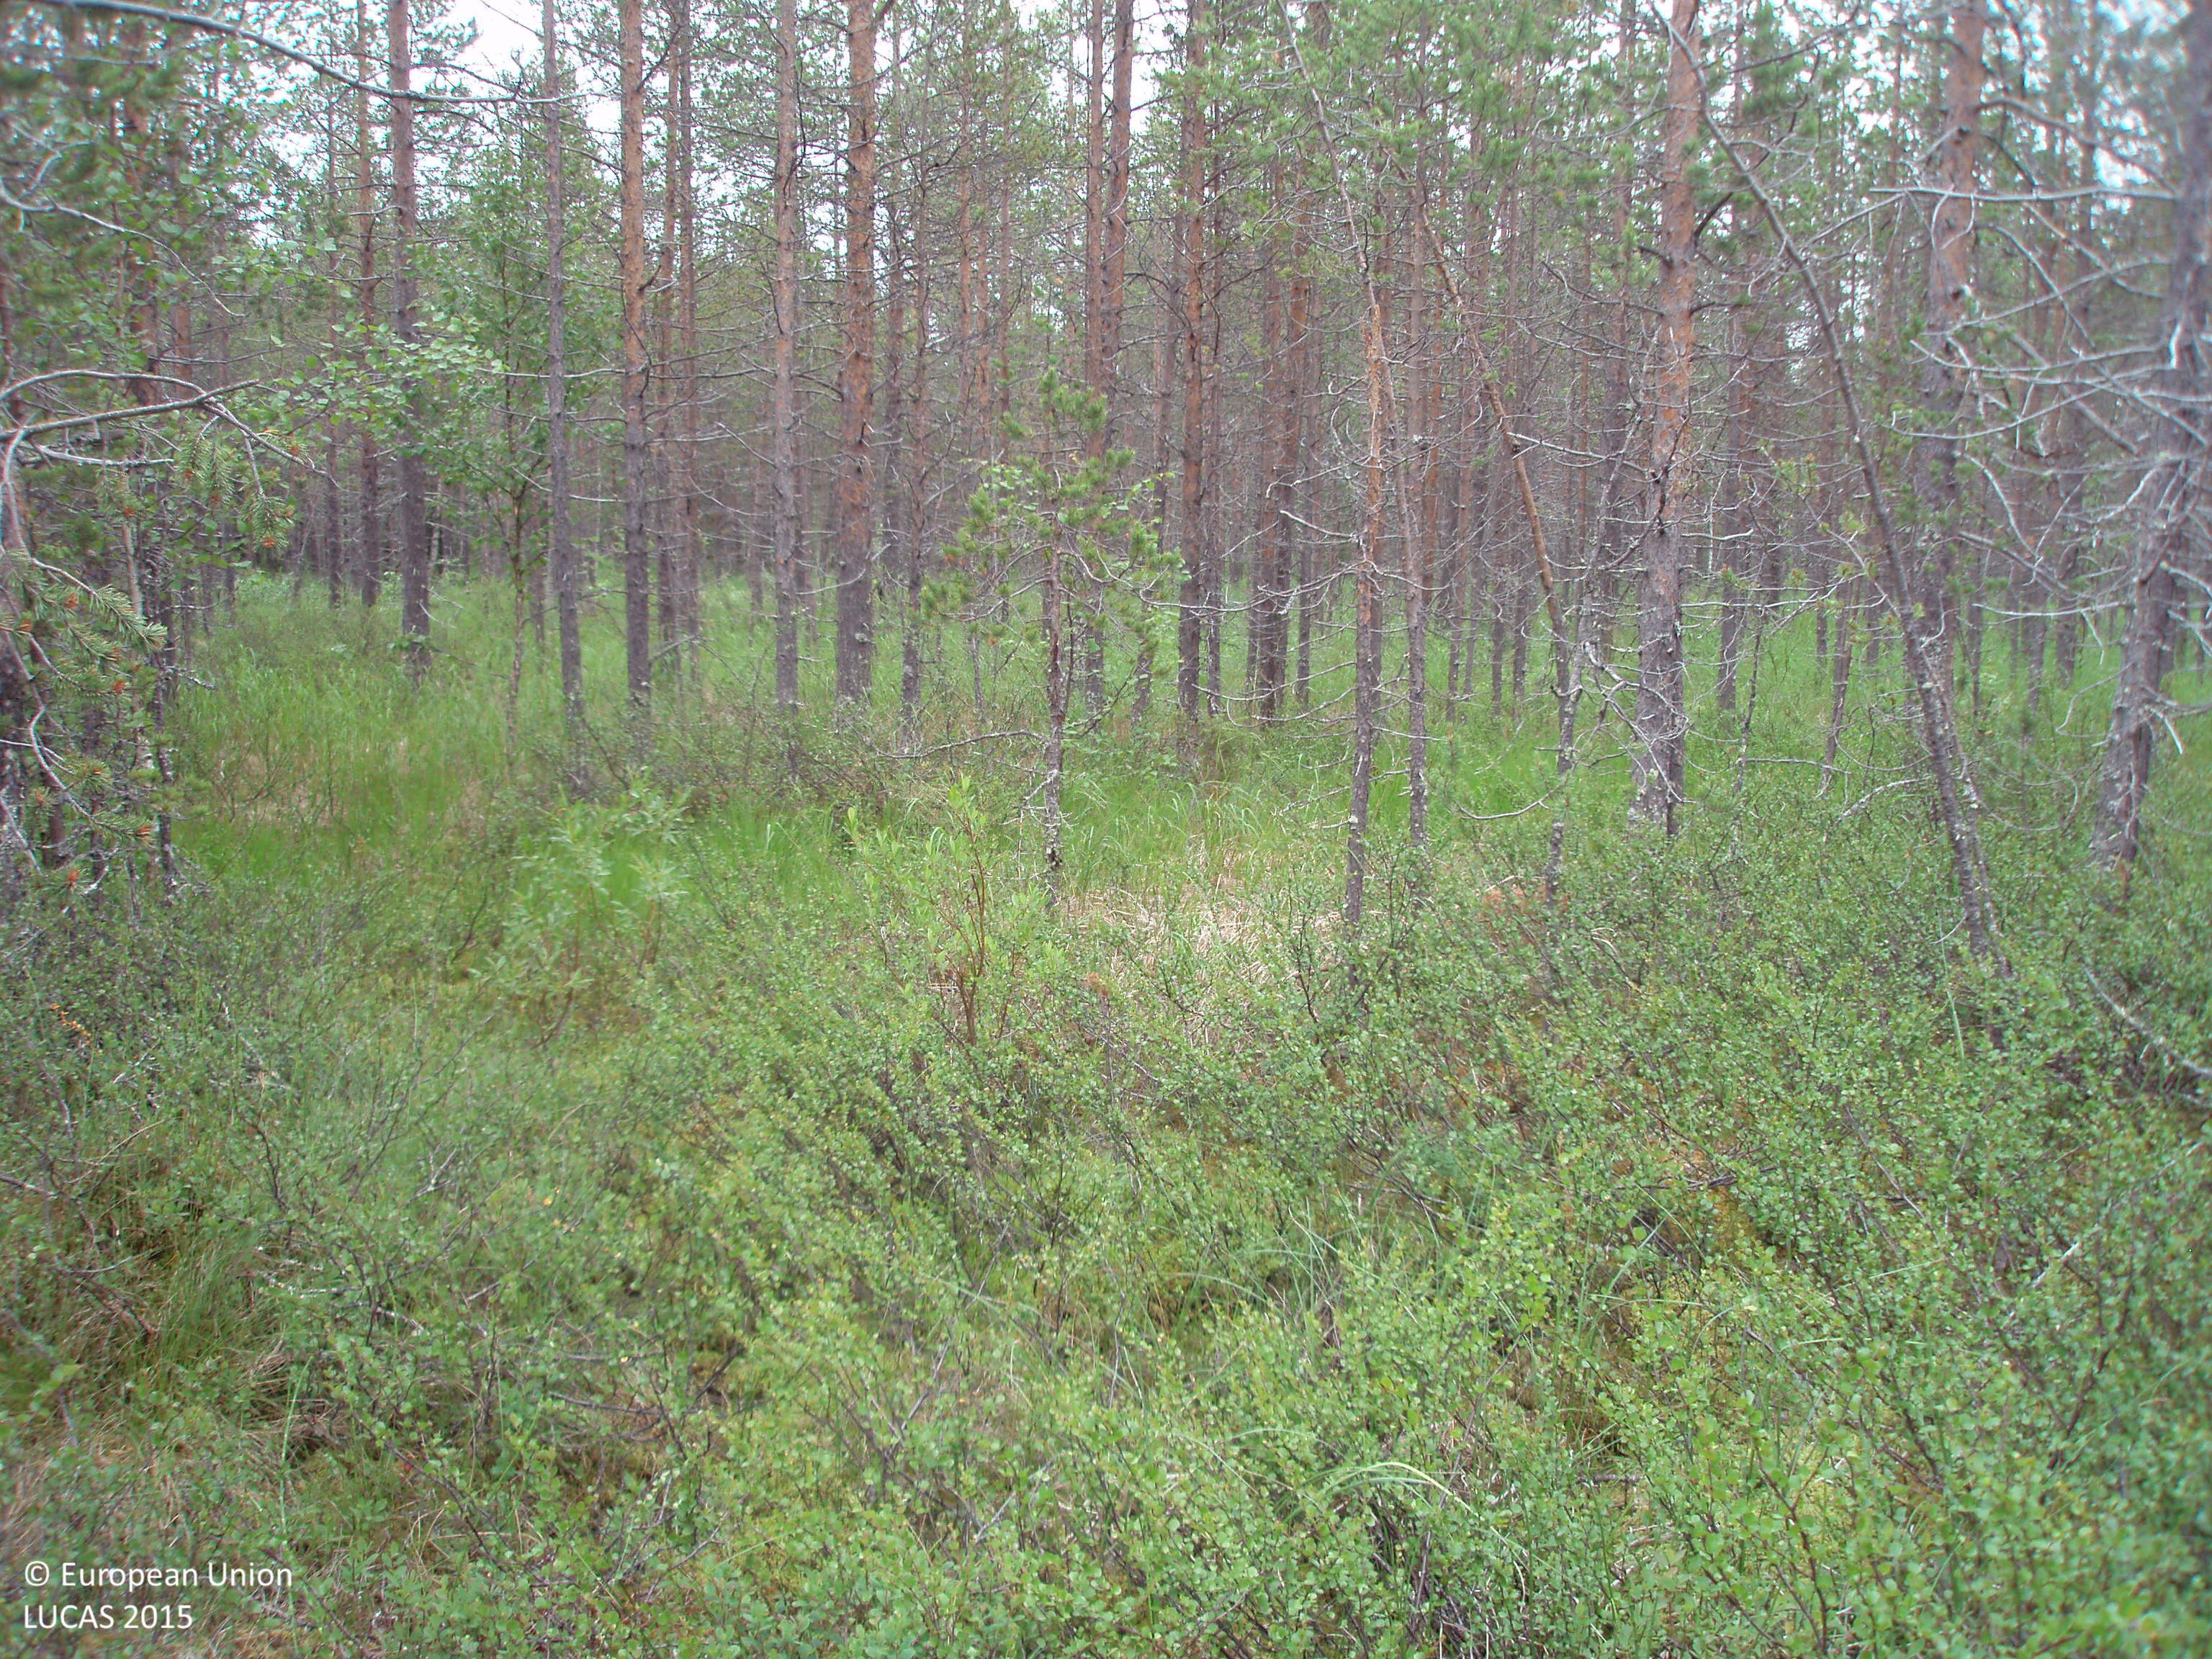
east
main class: Woodland
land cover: Pine dominated coniferous woodland
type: mire and swamp forests
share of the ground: 25 - 50 %
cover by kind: shrubs 45 %, coniferous forest trees 40 %, lichens and mosses 10 %, broadleaved forest trees 5 %
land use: Forestry
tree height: > 5 m
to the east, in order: Pine dominated coniferous woodland; Ditches and canals; Pine dominated mixed woodland; Pine dominated coniferous woodland; Other mixed woodland; Ditches and canals; Pine dominated mixed woodland; Pine dominated coniferous woodland; Ditches and canals; Other mixed woodland; Ditches and canals; Other mixed woodland
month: July
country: FI
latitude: 67.1963
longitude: 27.7040
